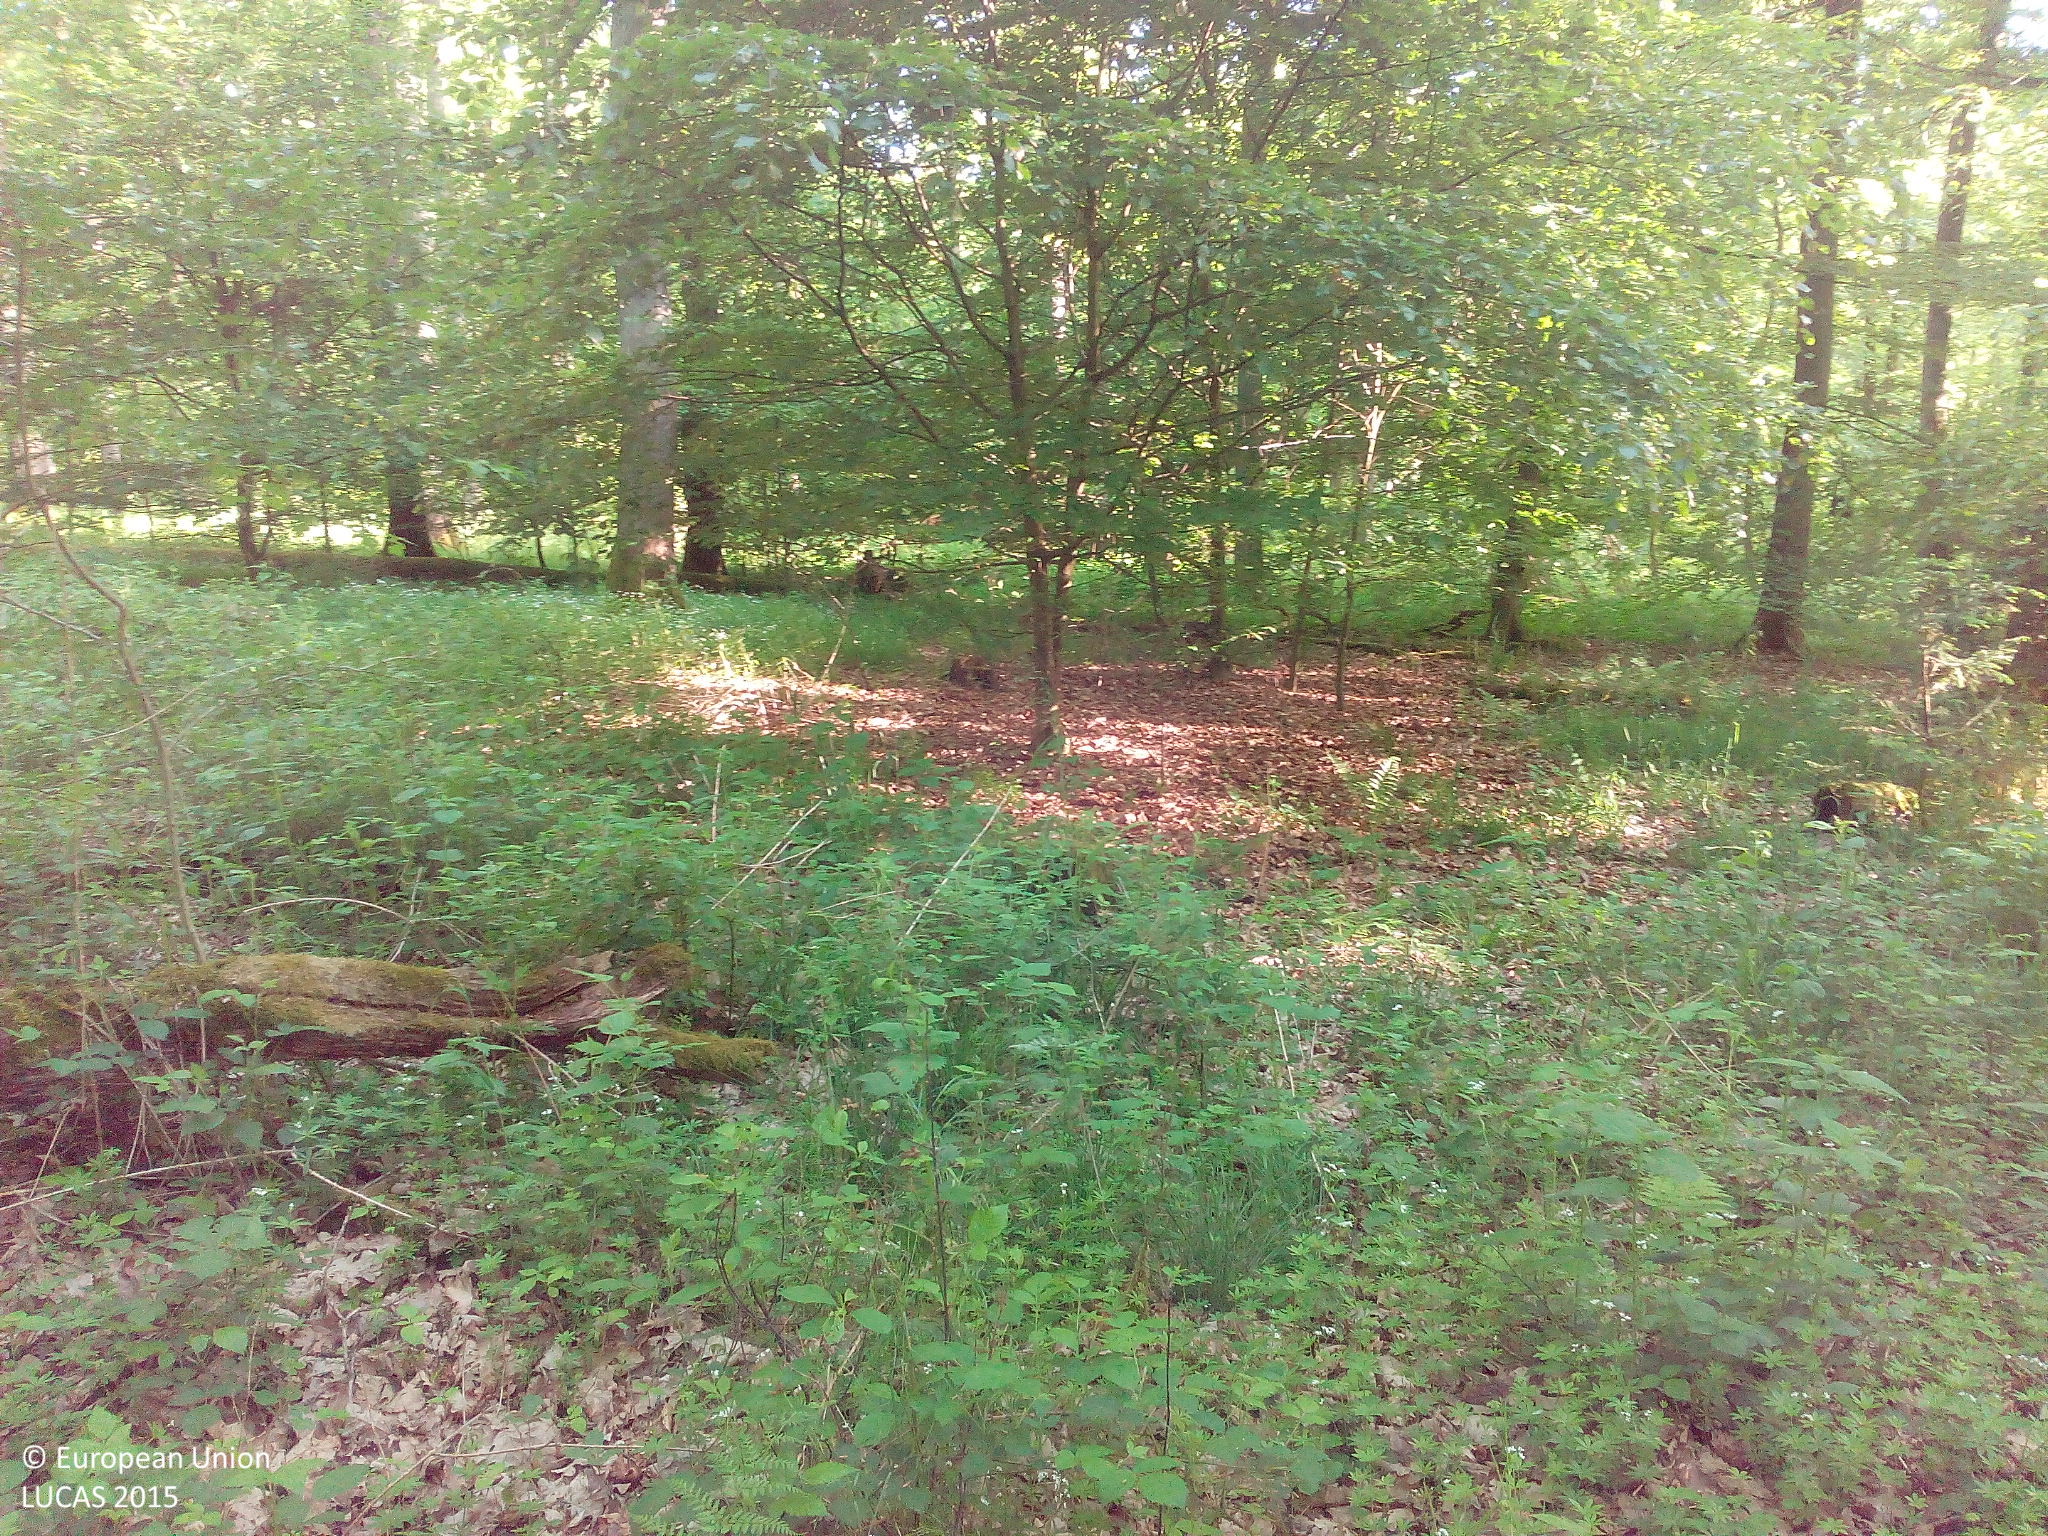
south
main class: Woodland
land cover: Broadleaved woodland
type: acidophilous oak and oak-birch forest
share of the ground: > 75 %
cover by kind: broadleaved forest trees 90 %, herbaceous plants 10 %
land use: Forestry
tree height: > 5 m
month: May
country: DE
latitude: 51.3163
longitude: 9.6127
